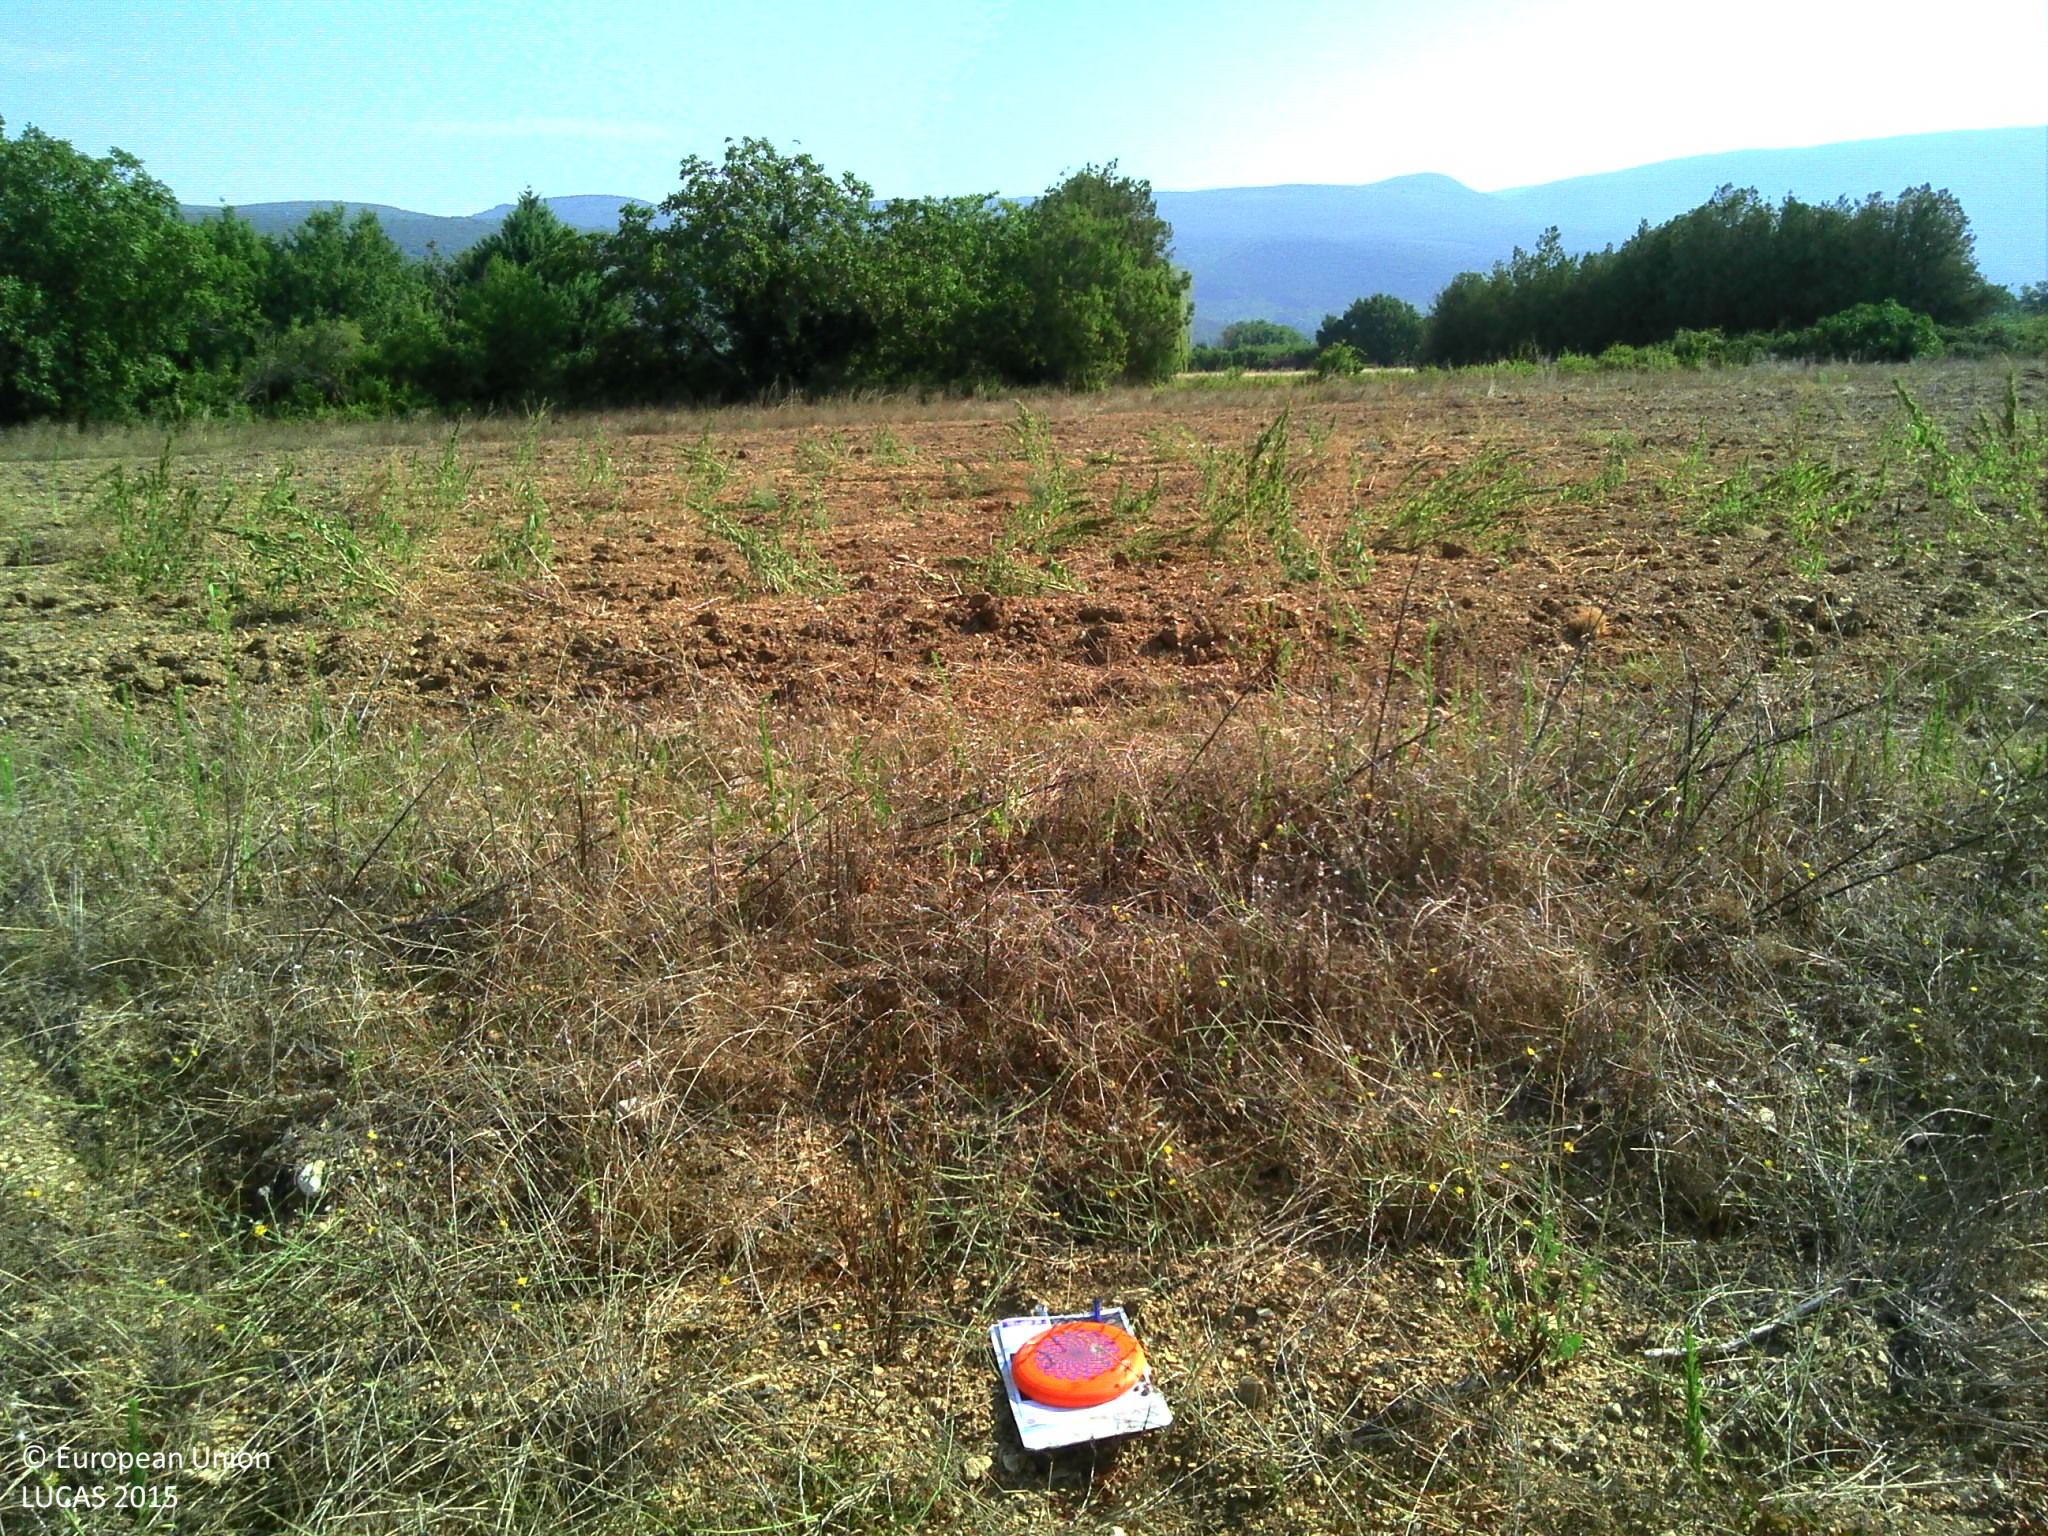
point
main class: Grassland
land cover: Spontaneously vegetated surfaces
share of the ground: > 75 %
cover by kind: herbaceous plants 70 %, unconsolidated bare surface 30 %
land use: Semi-natural and natural areas not in use
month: August
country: FR
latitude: 43.9240
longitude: 5.4127
